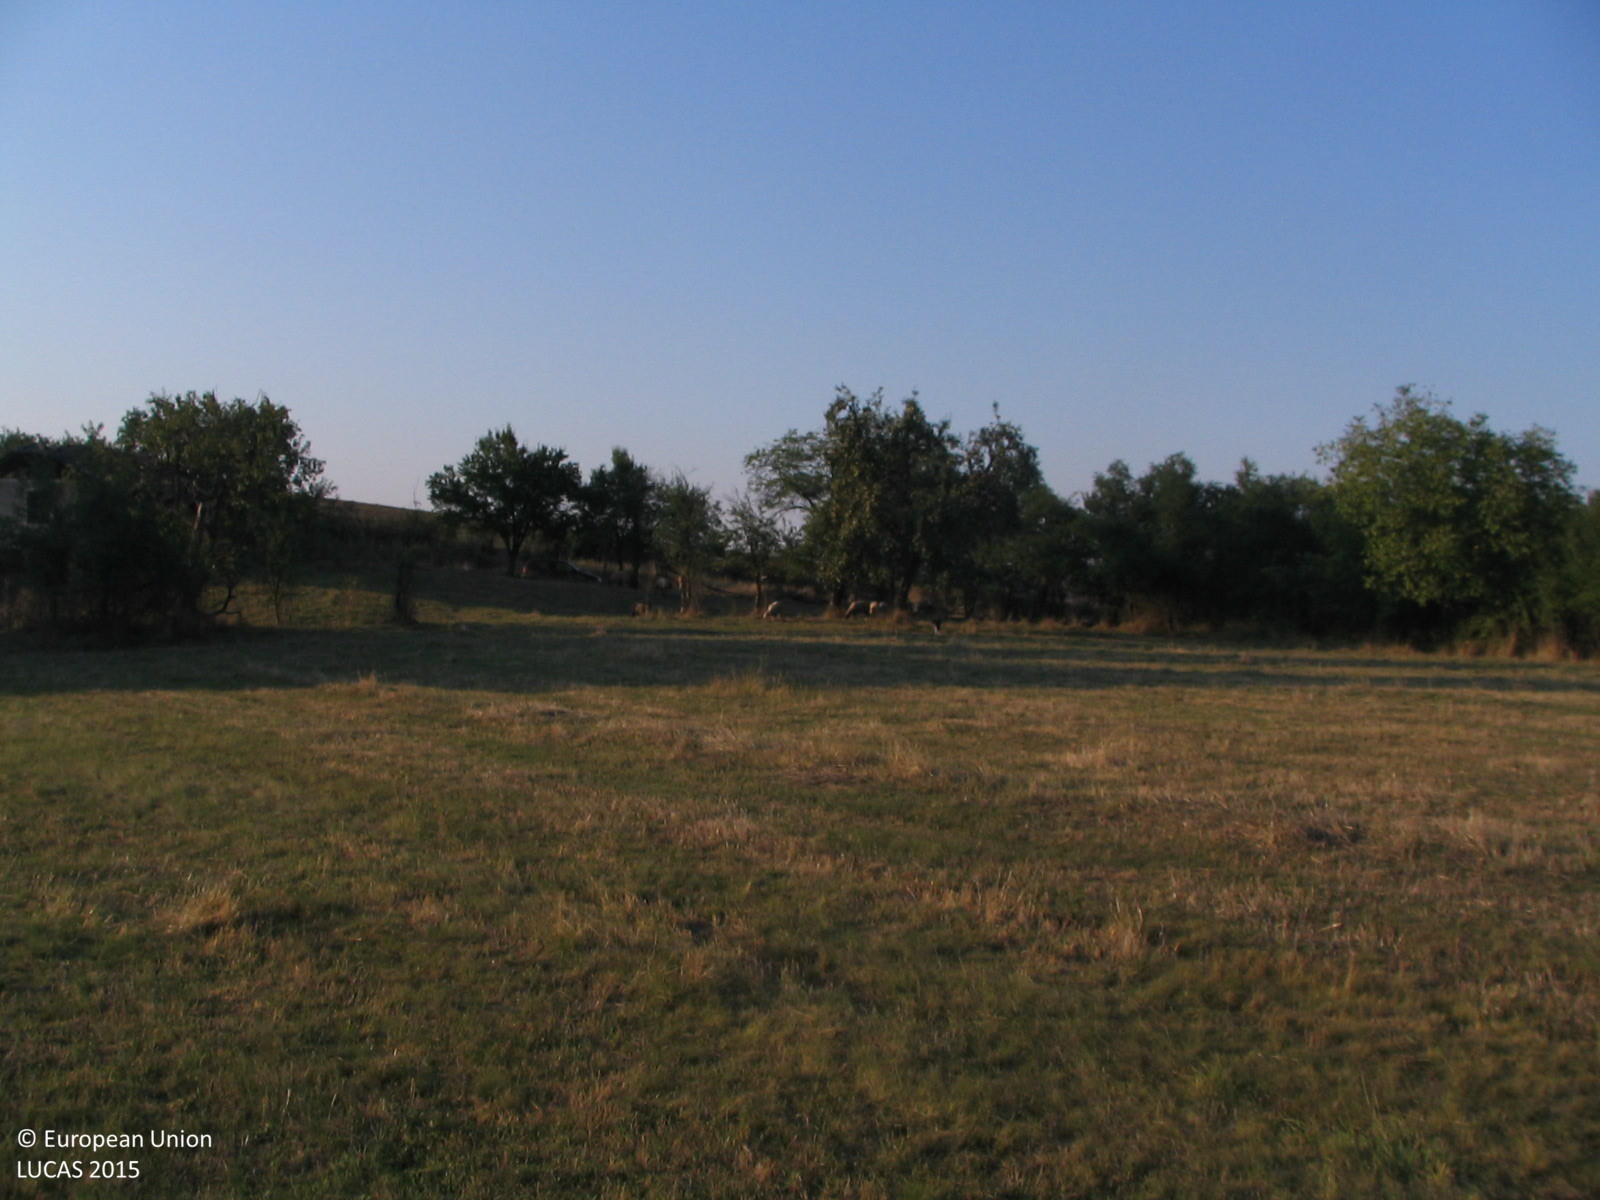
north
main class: Grassland
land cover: Grassland without tree/shrub cover
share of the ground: > 75 %
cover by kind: herbaceous plants 95 %, shrubs 5 %
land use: Agriculture (excluding fallow land and kitchen gardens)
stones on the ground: < 10 %
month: August
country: BG
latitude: 43.0959
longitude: 24.4432
